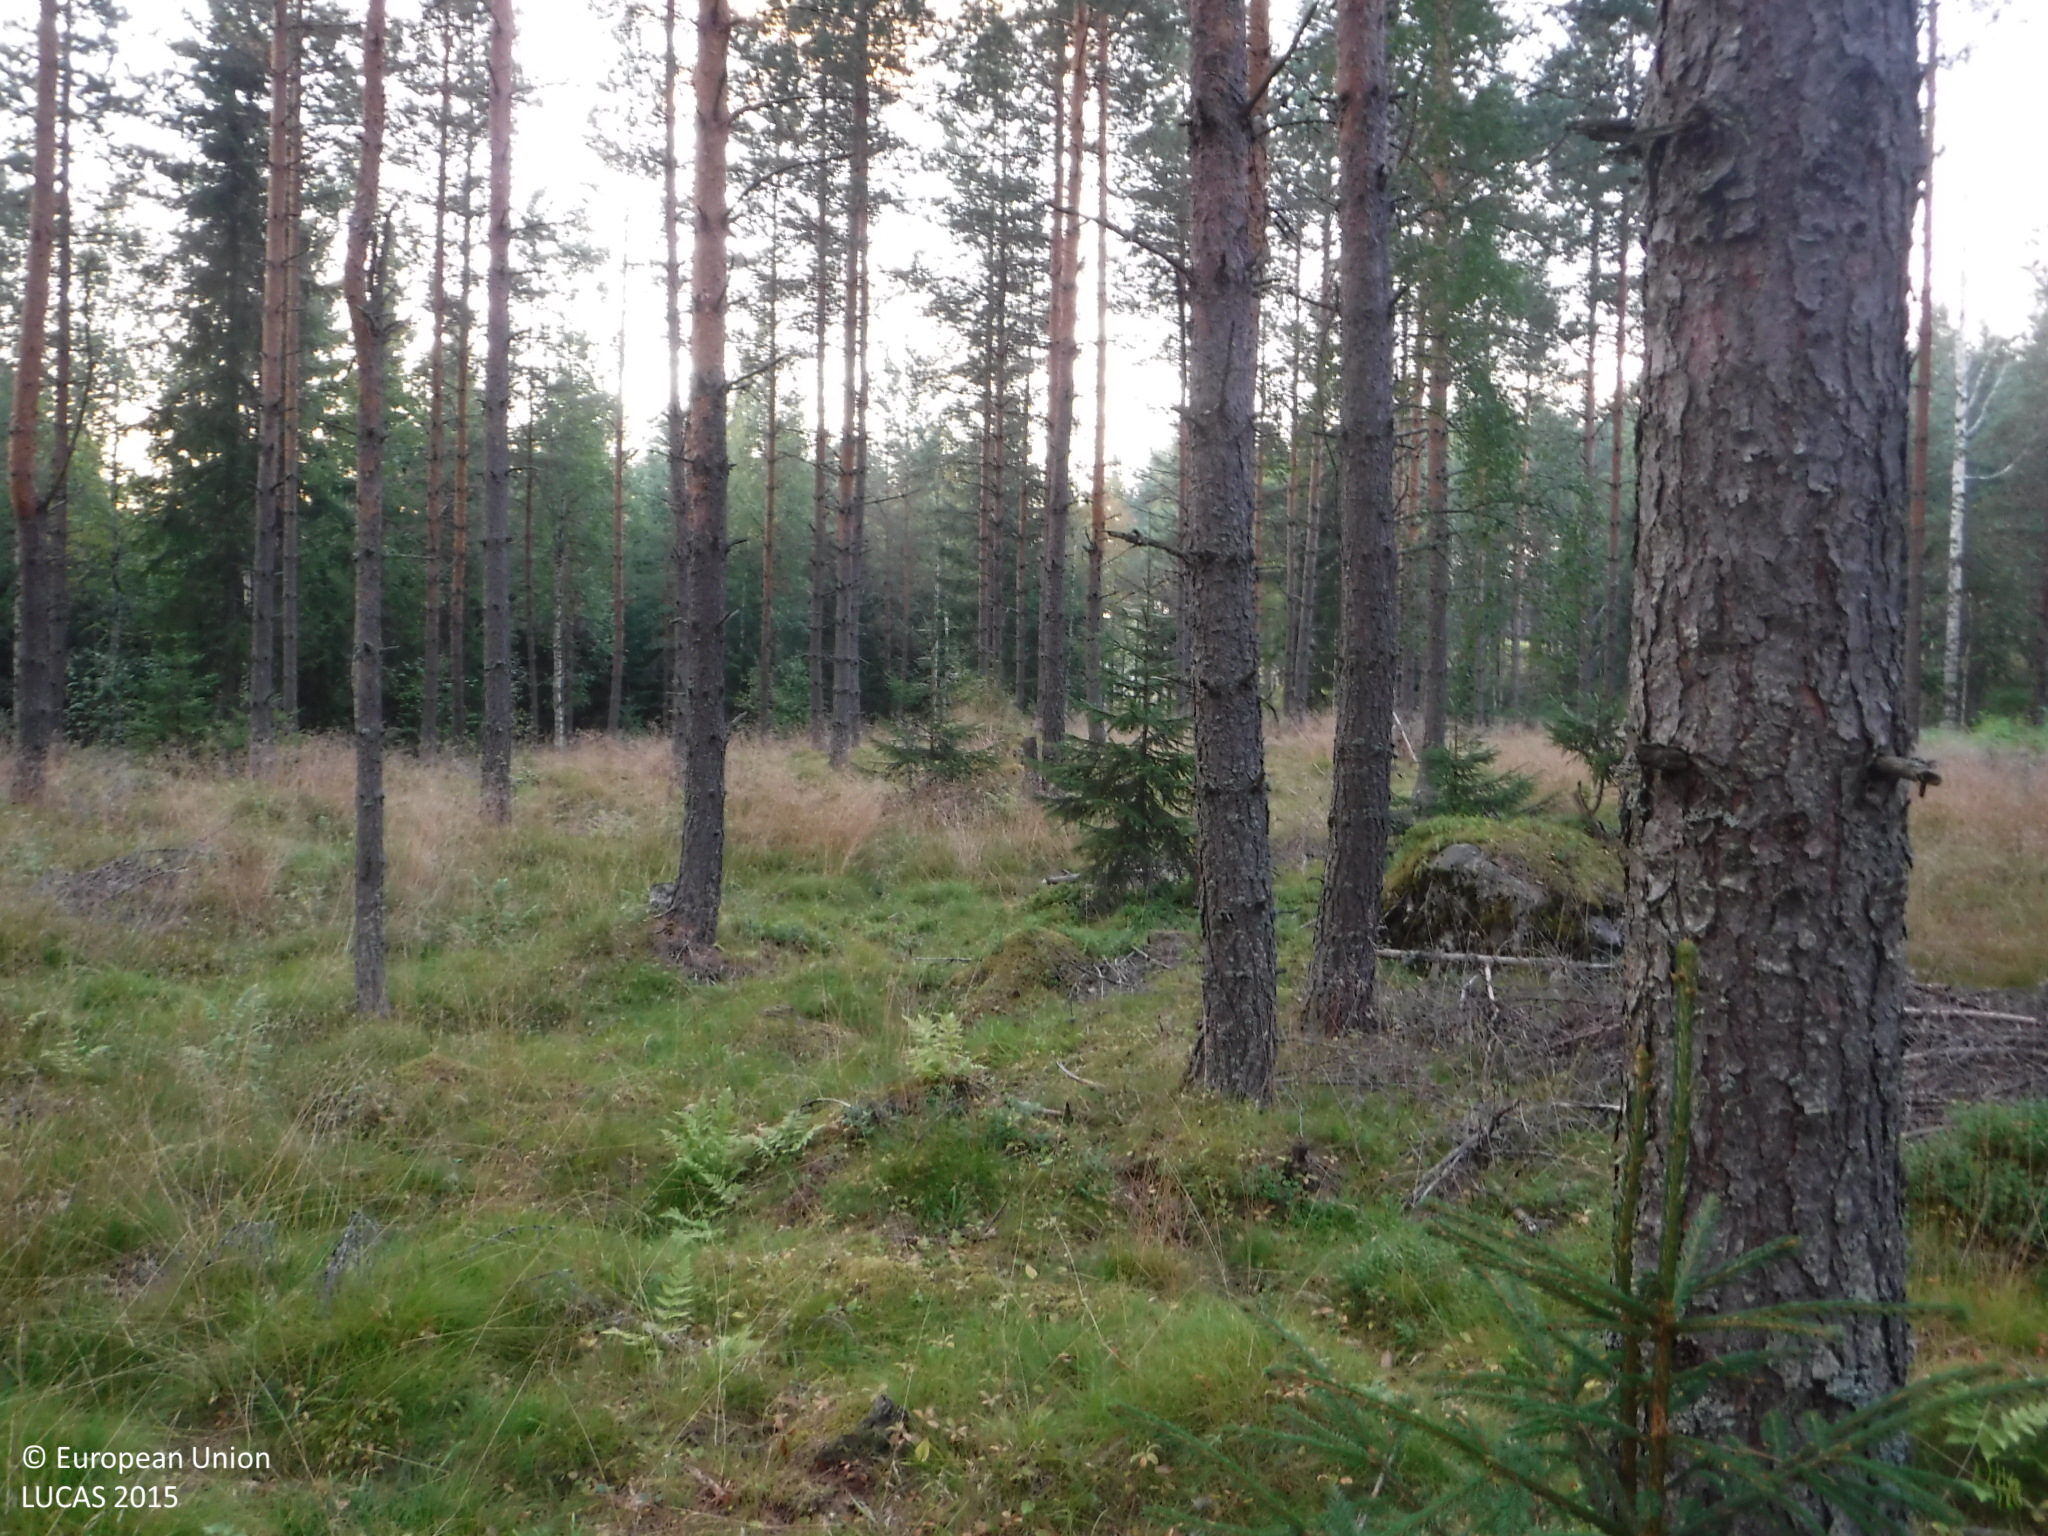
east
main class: Woodland
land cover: Pine dominated coniferous woodland
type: boreal forest
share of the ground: 50 - 75 %
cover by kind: coniferous forest trees 50 %, herbaceous plants 25 %, lichens and mosses 20 %, shrubs 5 %
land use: Forestry
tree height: > 5 m
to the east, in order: Pine dominated coniferous woodland; Other coniferous woodland; Ditches and canals; Spruce dominated coniferous woodland; Ditches and canals; Shrubland with sparse tree cover
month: August
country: FI
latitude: 61.1081
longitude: 23.0438
